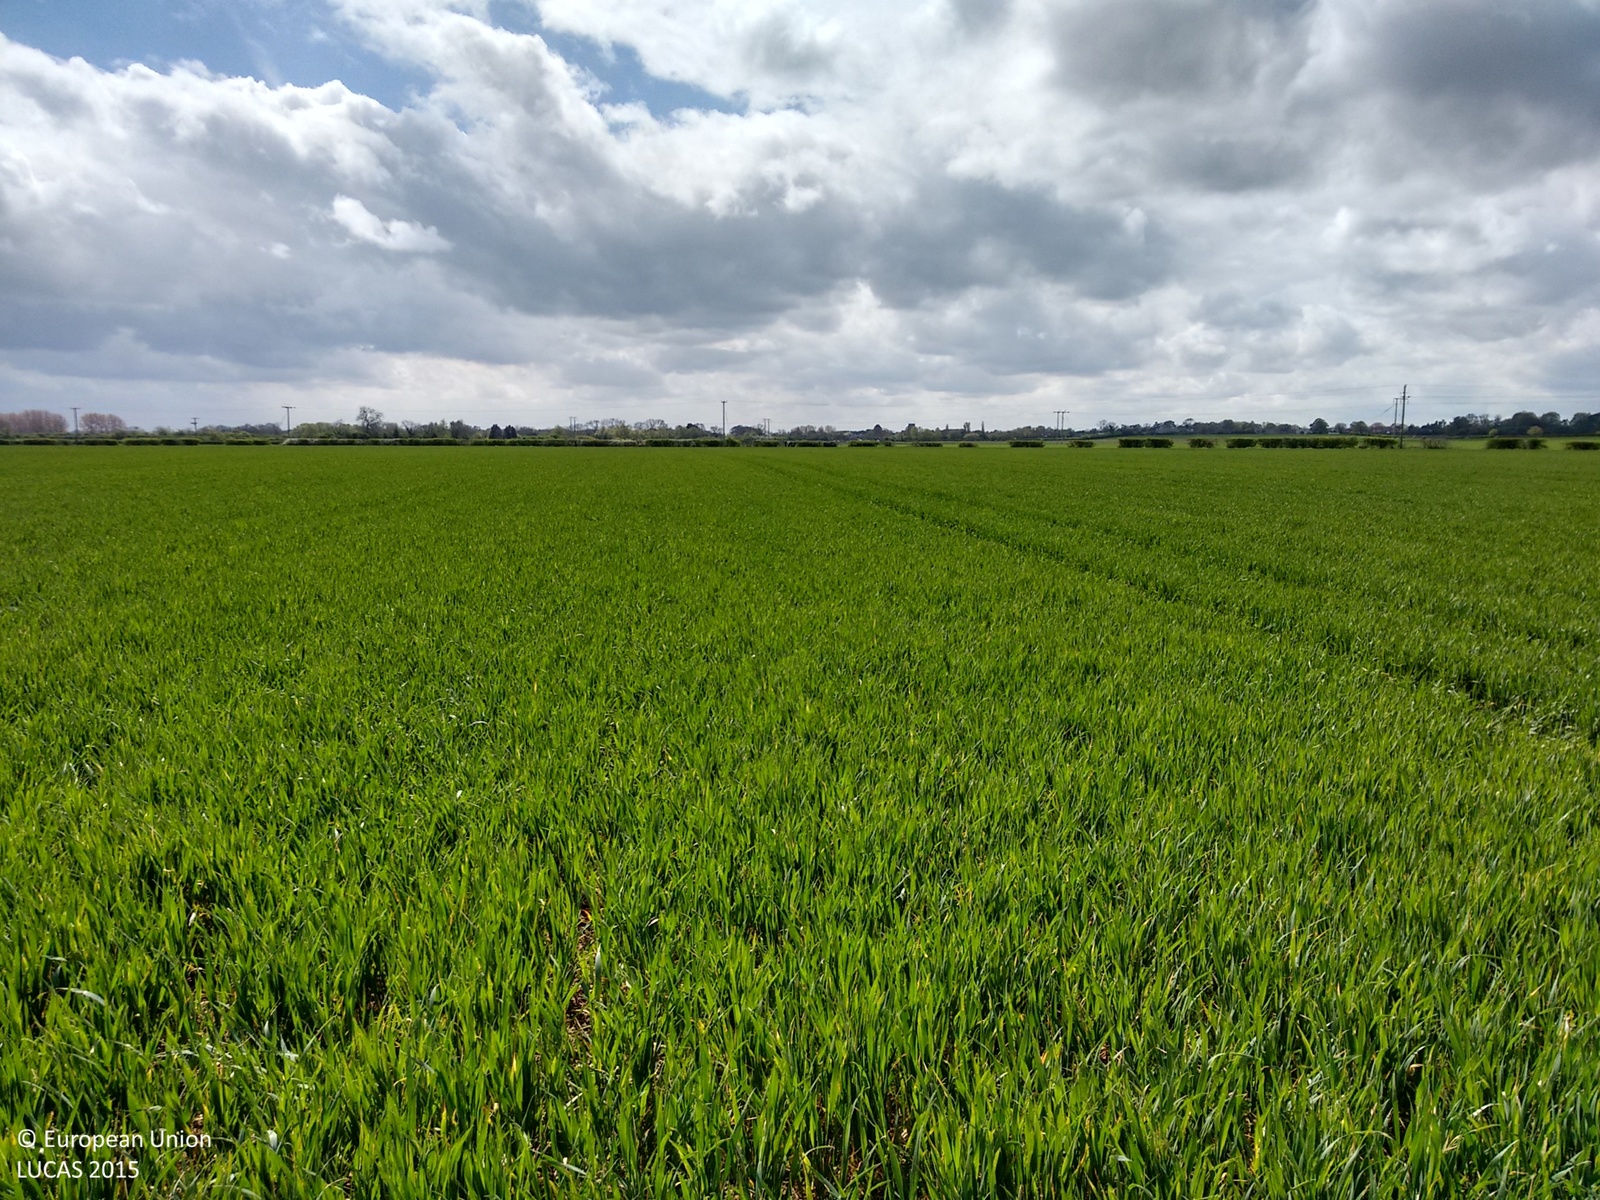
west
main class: Cropland
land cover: Common wheat
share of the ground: > 75 %
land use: Agriculture (excluding fallow land and kitchen gardens)
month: May
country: GB
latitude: 54.0254
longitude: -0.3694
